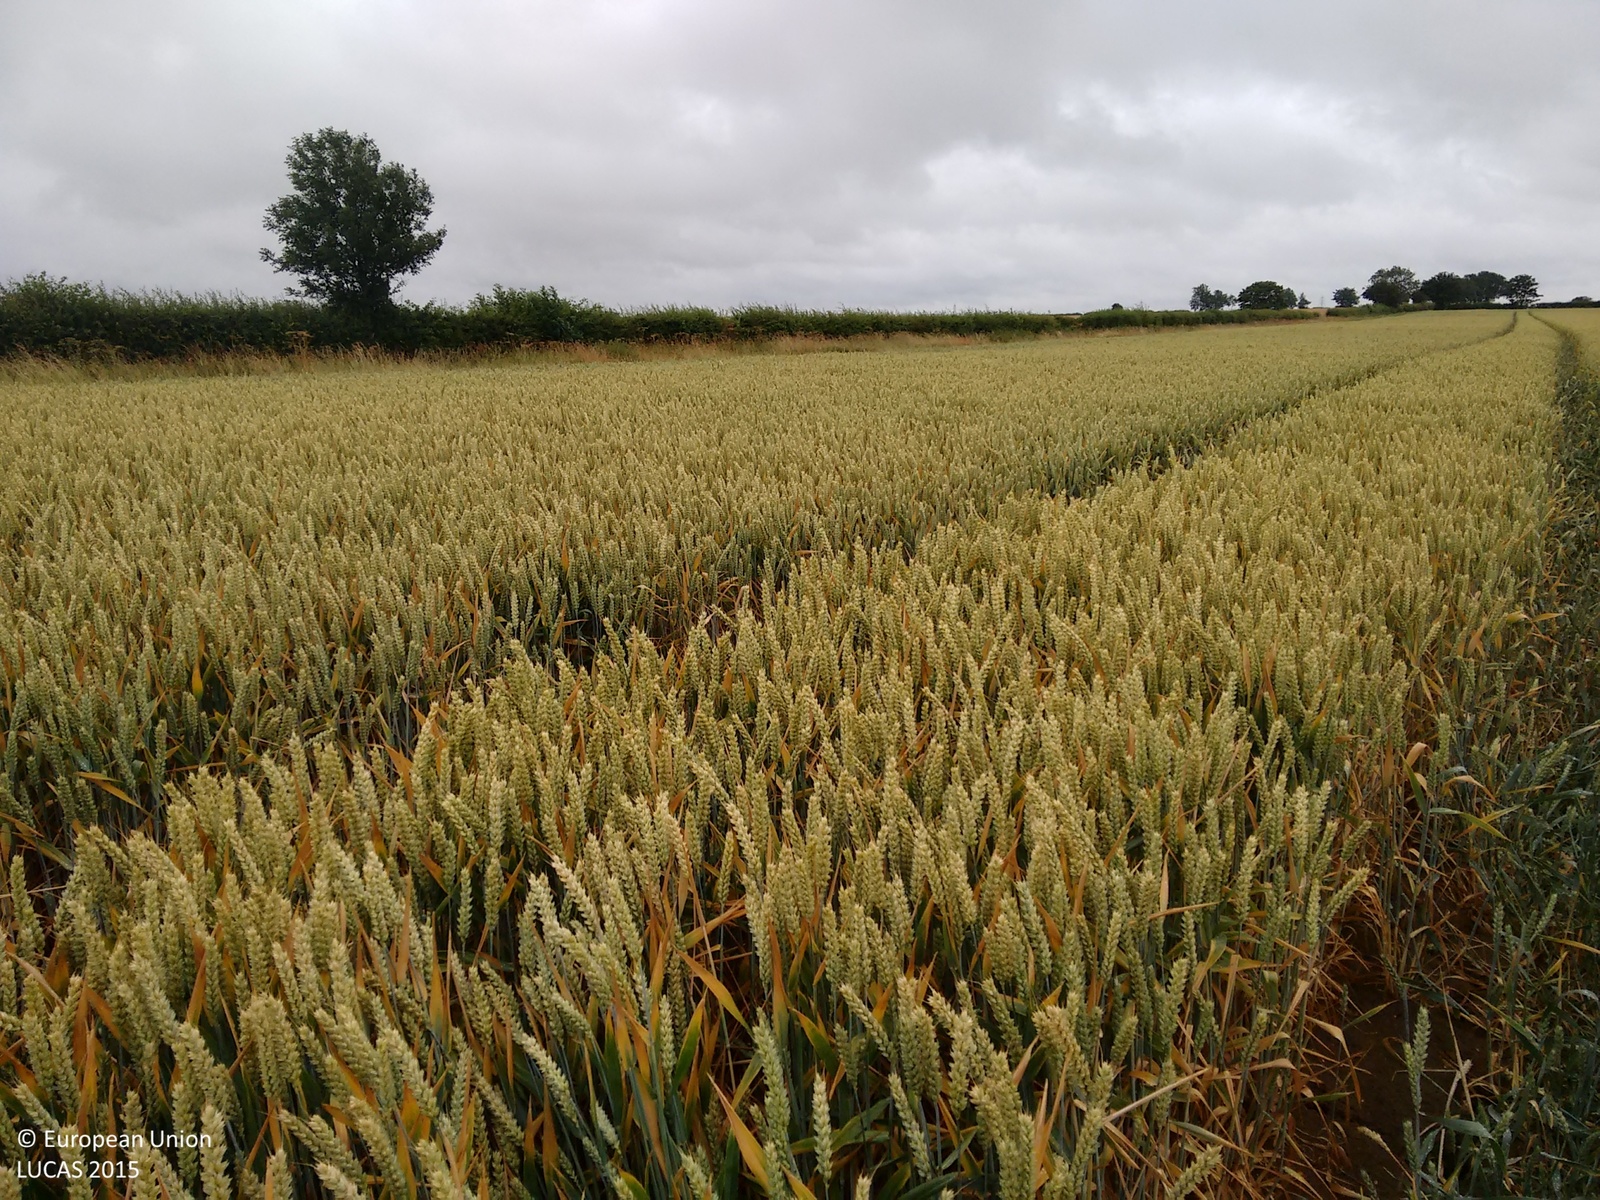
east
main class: Cropland
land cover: Common wheat
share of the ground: > 75 %
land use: Agriculture (excluding fallow land and kitchen gardens)
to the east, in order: Common wheat; Grass margins; Tracks; Grassland without tree/shrub cover; Managed hedges; Grass margins; Rape and turnip rape
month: July
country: GB
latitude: 52.5002
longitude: -0.3926
